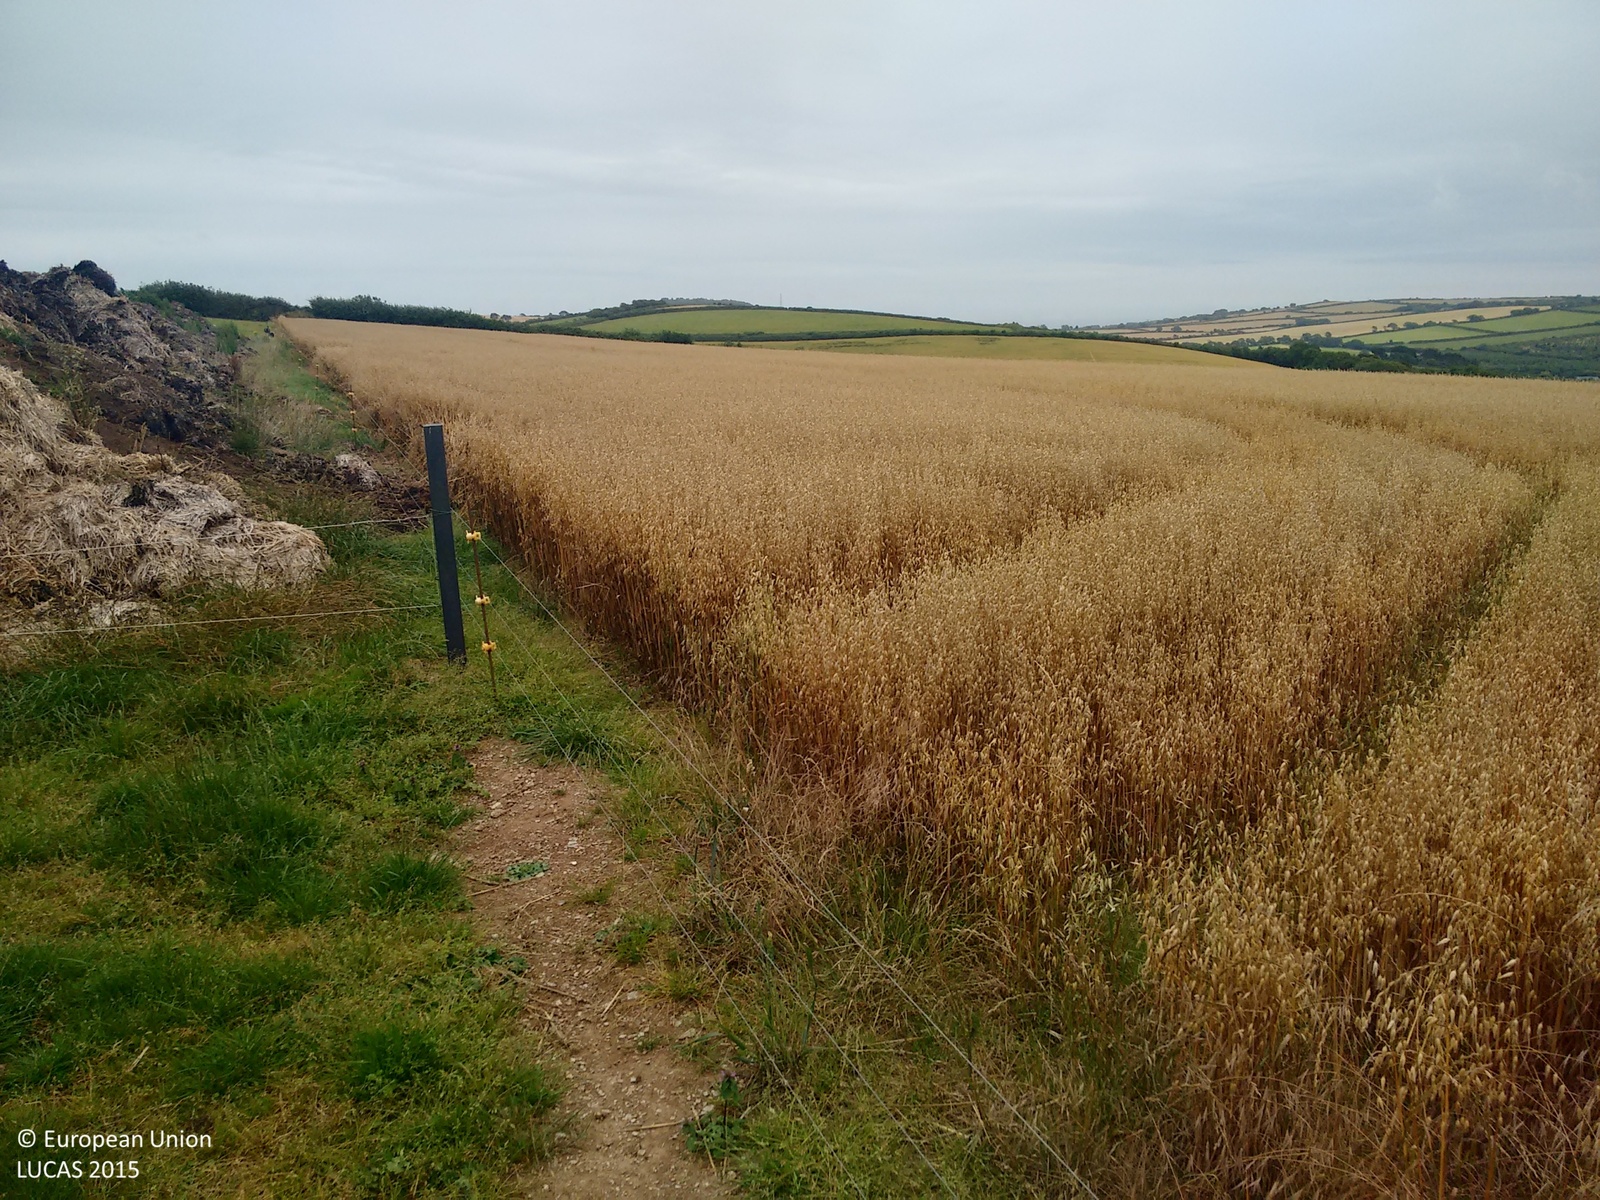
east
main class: Cropland
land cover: Oats
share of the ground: > 75 %
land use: Agriculture (excluding fallow land and kitchen gardens)
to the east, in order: Oats; Managed hedges; Common wheat
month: August
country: GB
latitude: 50.2634
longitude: -3.7088
